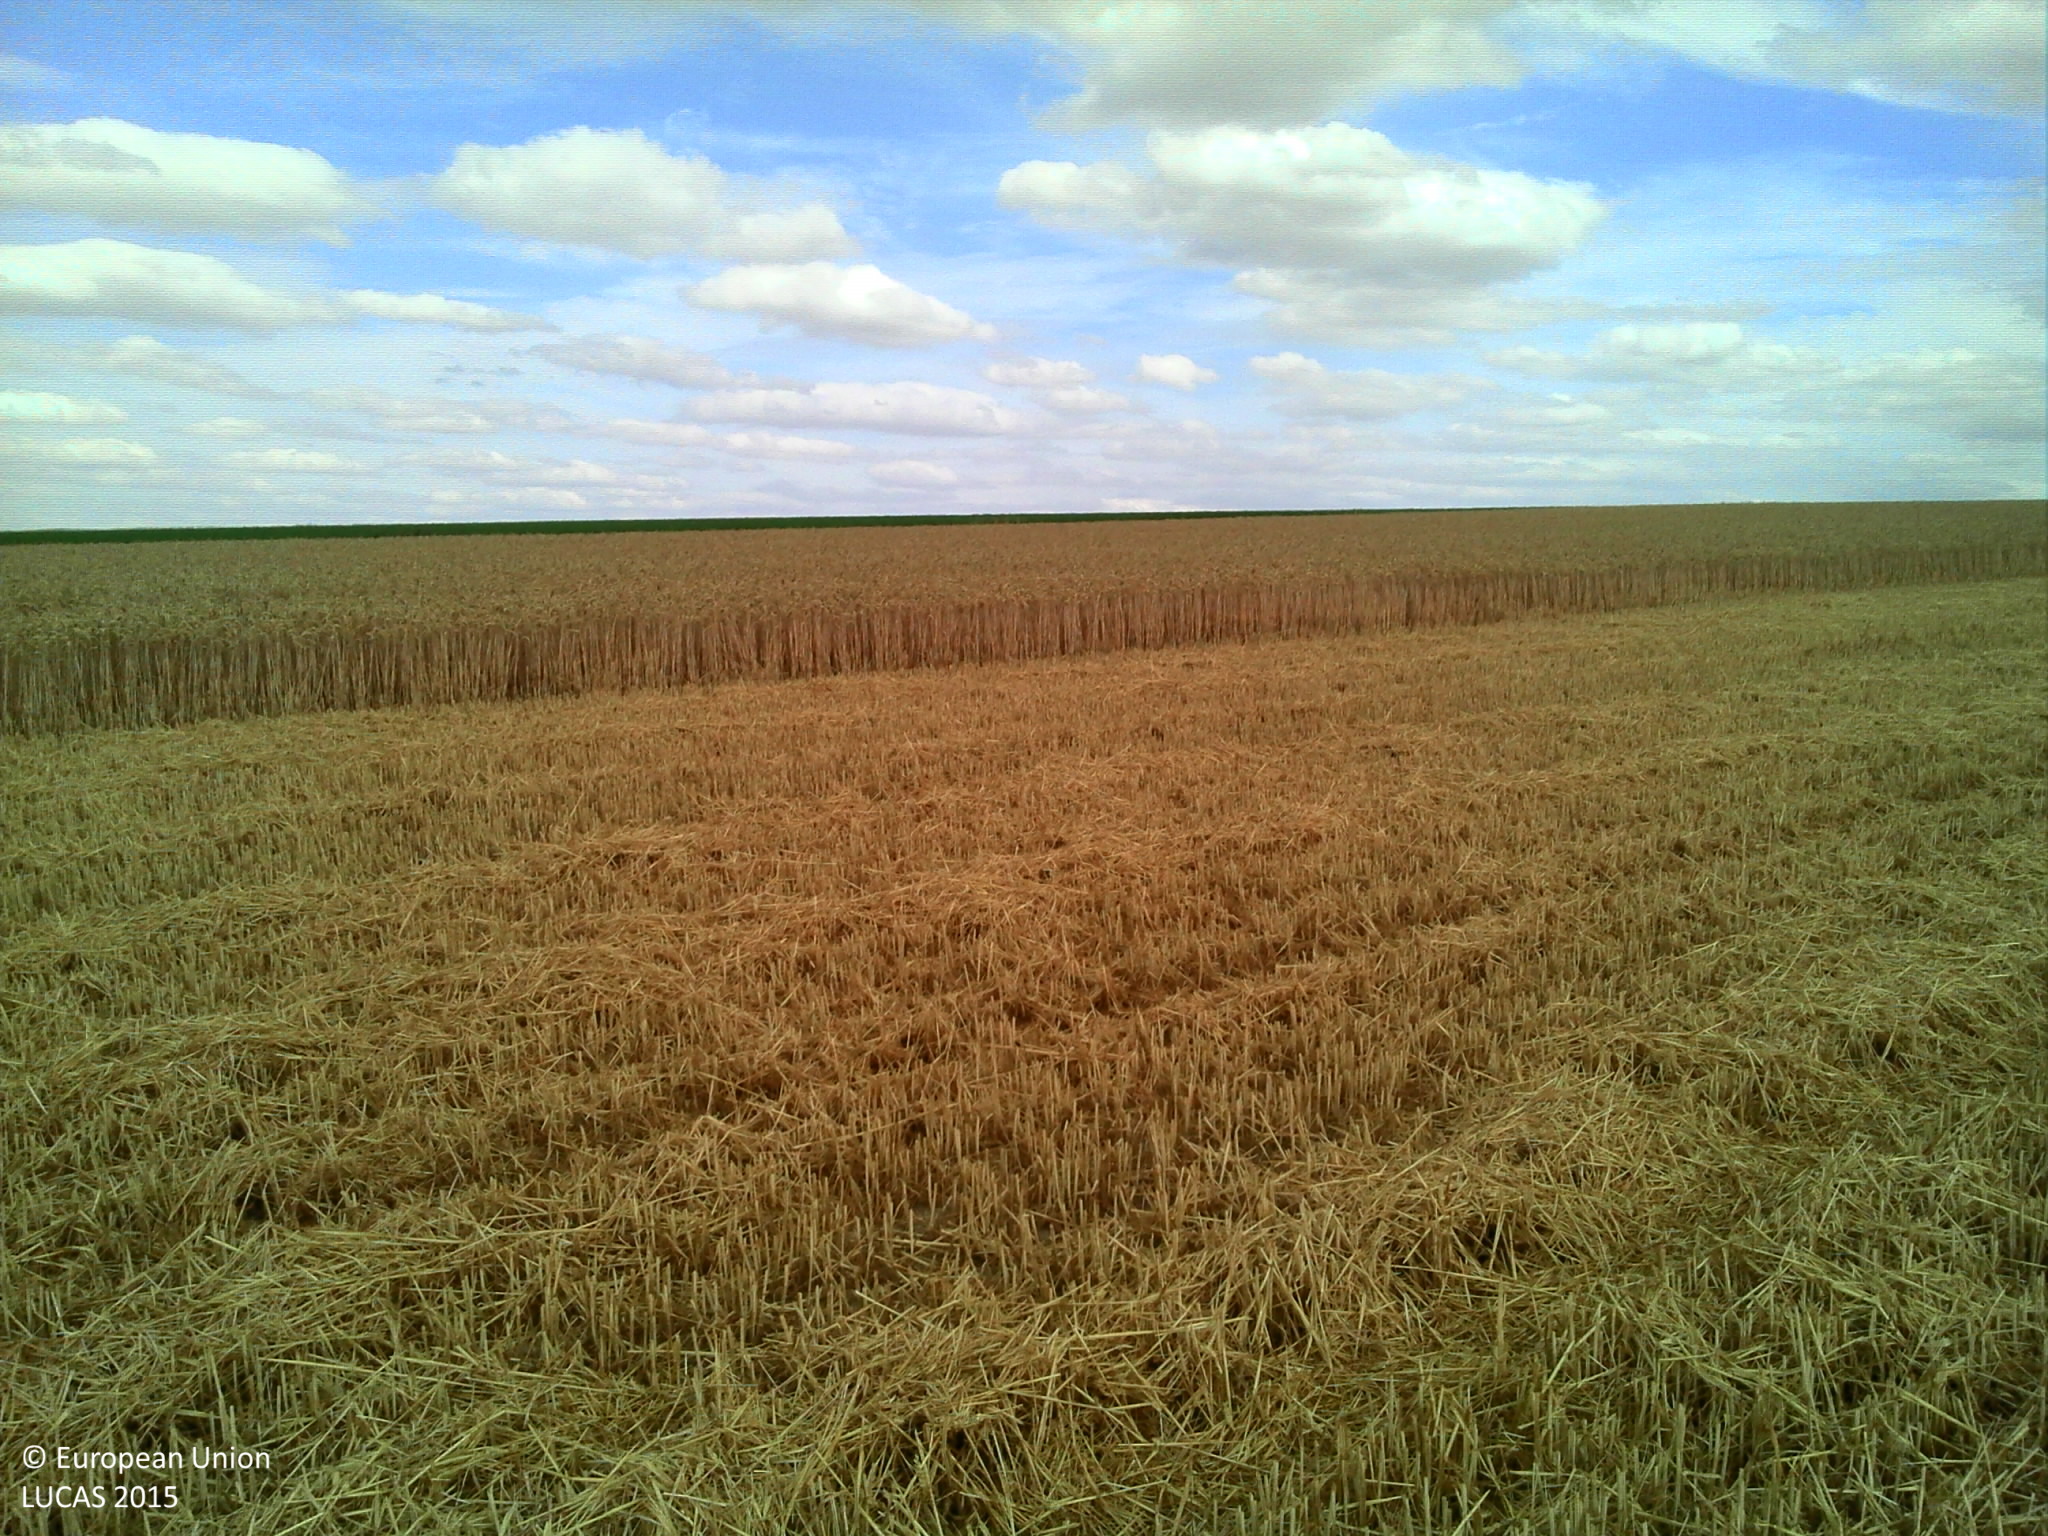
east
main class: Cropland
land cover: Common wheat
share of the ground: > 75 %
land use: Agriculture (excluding fallow land and kitchen gardens)
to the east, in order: Common wheat; Clovers; Grass margins; Tracks
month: July
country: FR
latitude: 49.3321
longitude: 4.1746
